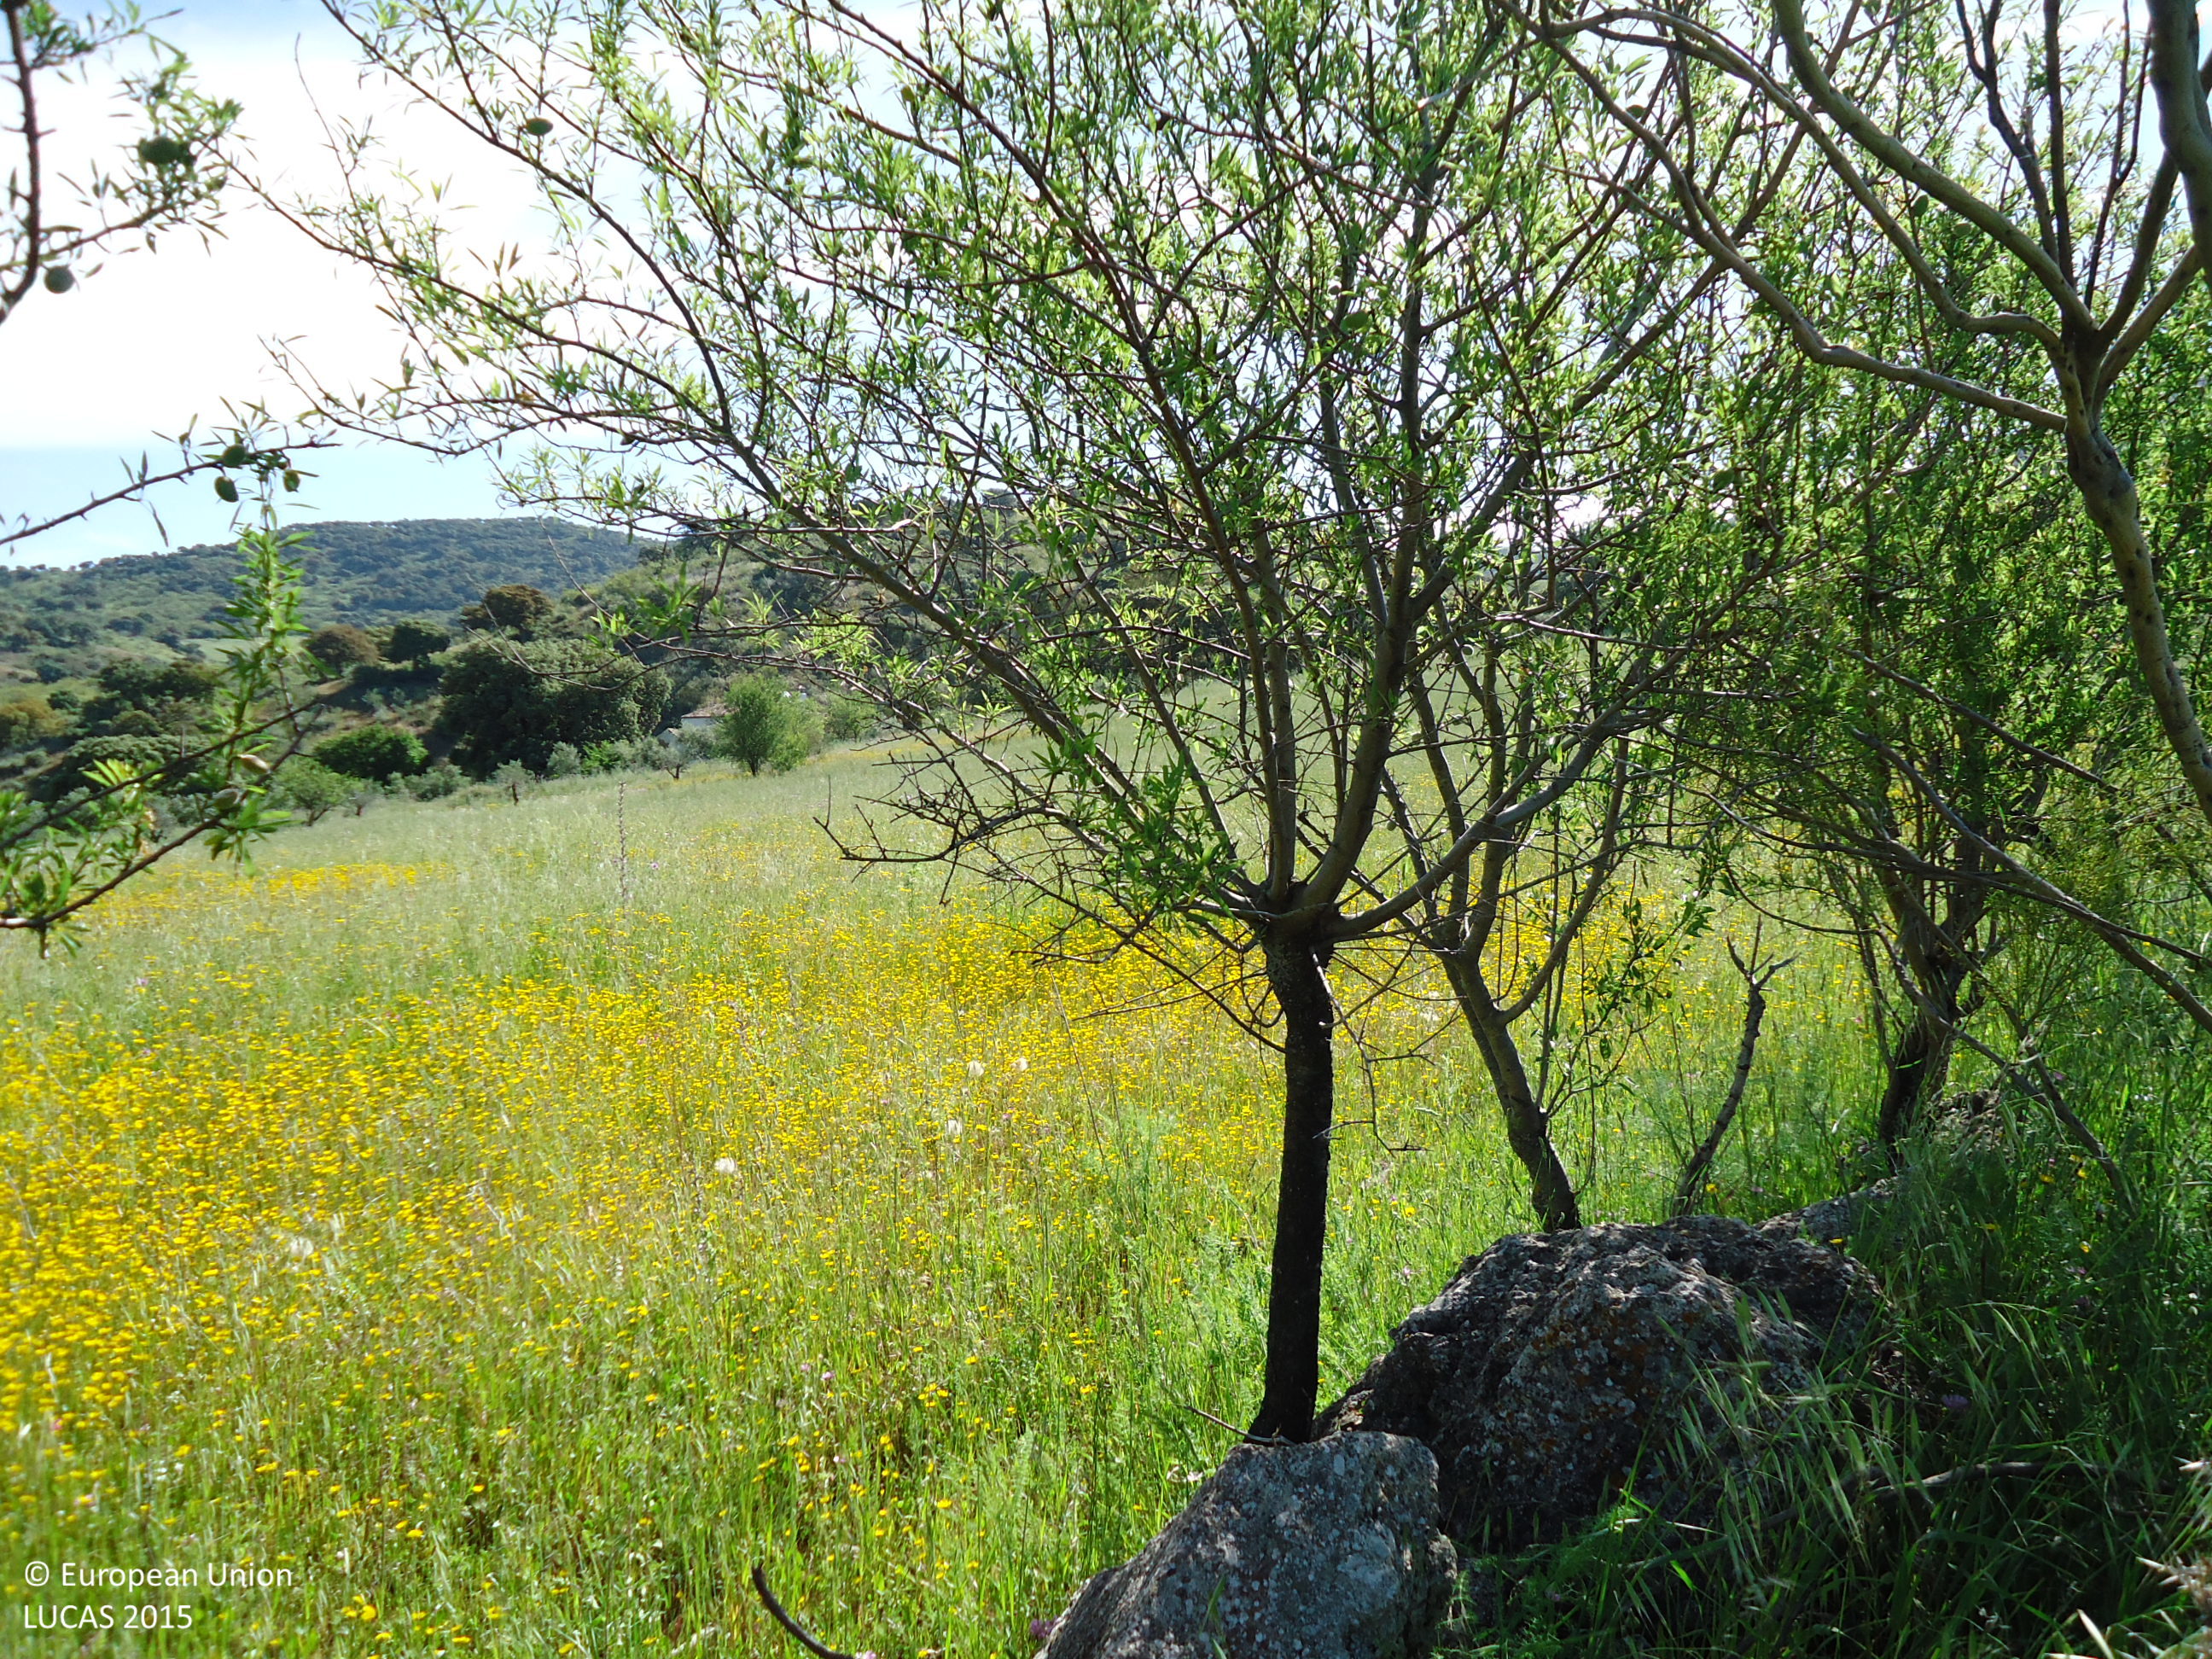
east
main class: Cropland
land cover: Mixed cereals for fodder
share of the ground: > 75 %
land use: Agriculture (excluding fallow land and kitchen gardens)
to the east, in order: Mixed cereals for fodder; Fences; Lines of trees; Mixed cereals for fodder; Broadleaved woodland; Tracks; Lines of trees; Grassland without tree/shrub cover; Single bushes/trees; Grassland without tree/shrub cover
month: May
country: ES
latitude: 36.8495
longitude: -5.3116
